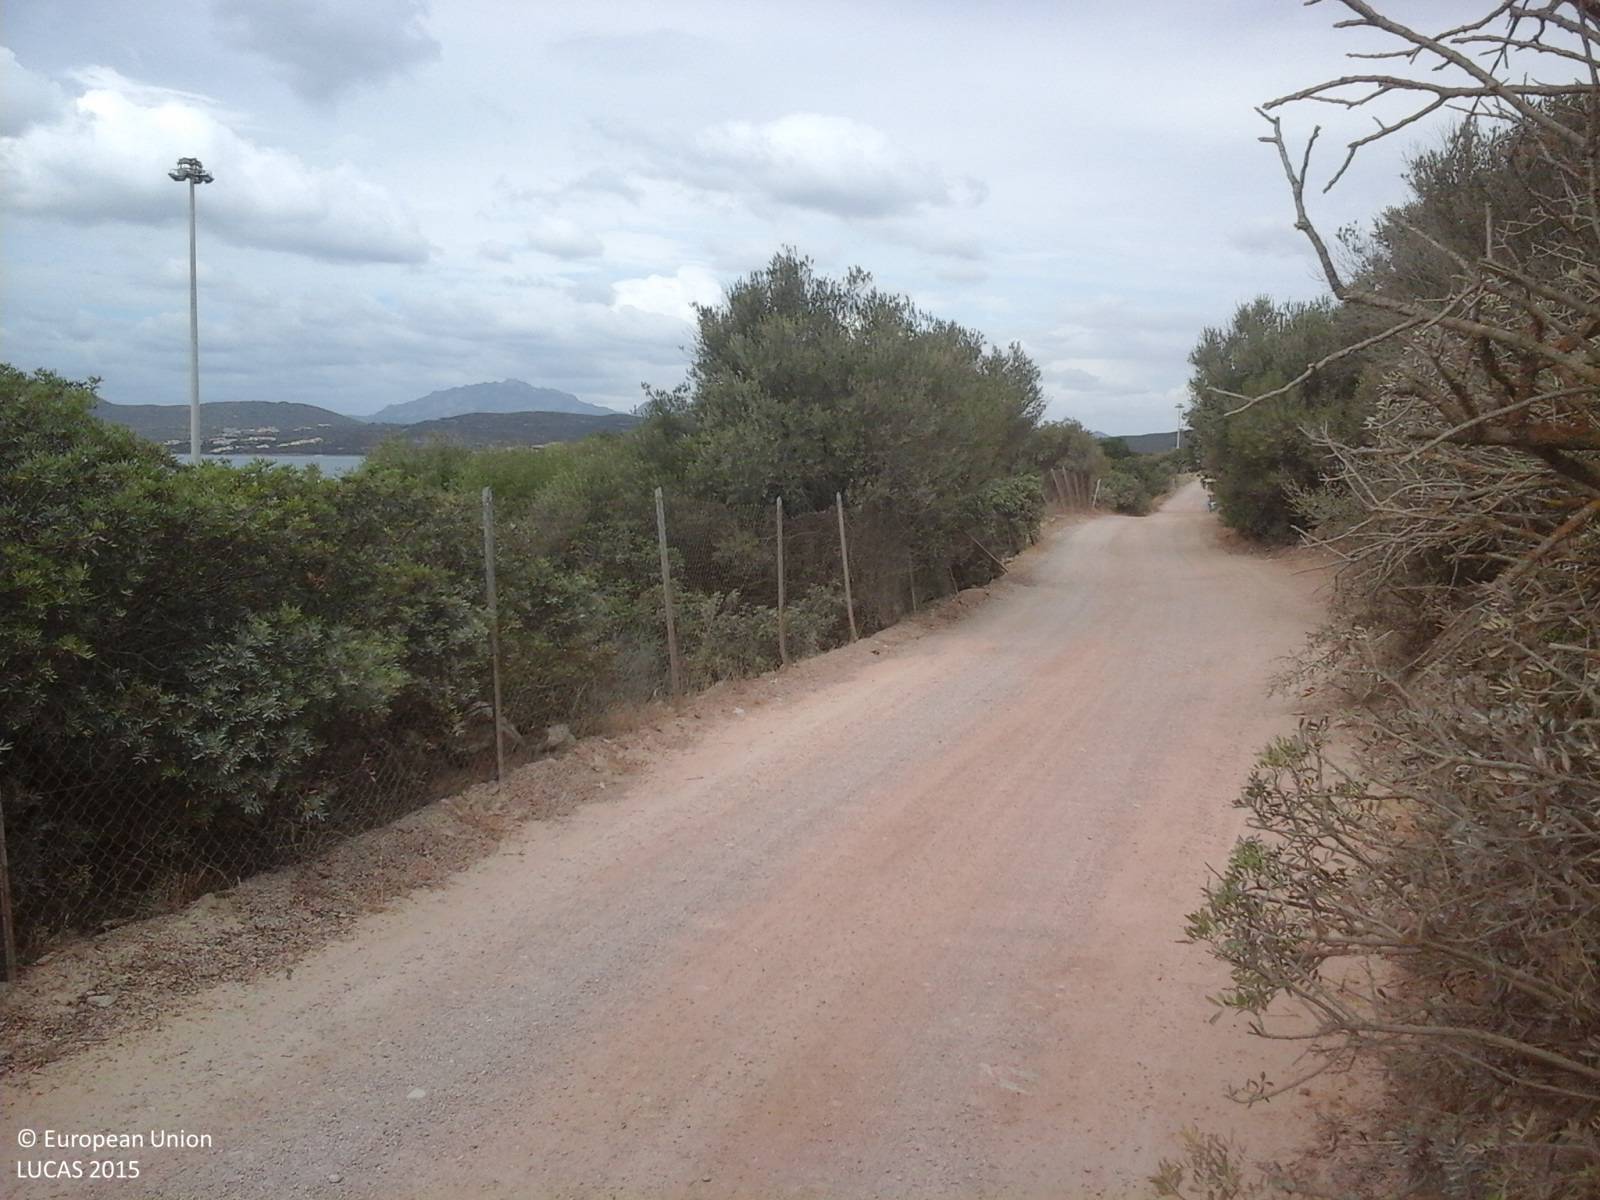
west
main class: Shrubland
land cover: Shrubland with sparse tree cover
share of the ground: > 75 %
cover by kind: shrubs 85 %, unconsolidated bare surface 10 %, broadleaved forest trees 5 %
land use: Semi-natural and natural areas not in use
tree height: > 5 m
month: August
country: IT
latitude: 40.9905
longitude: 9.6332
